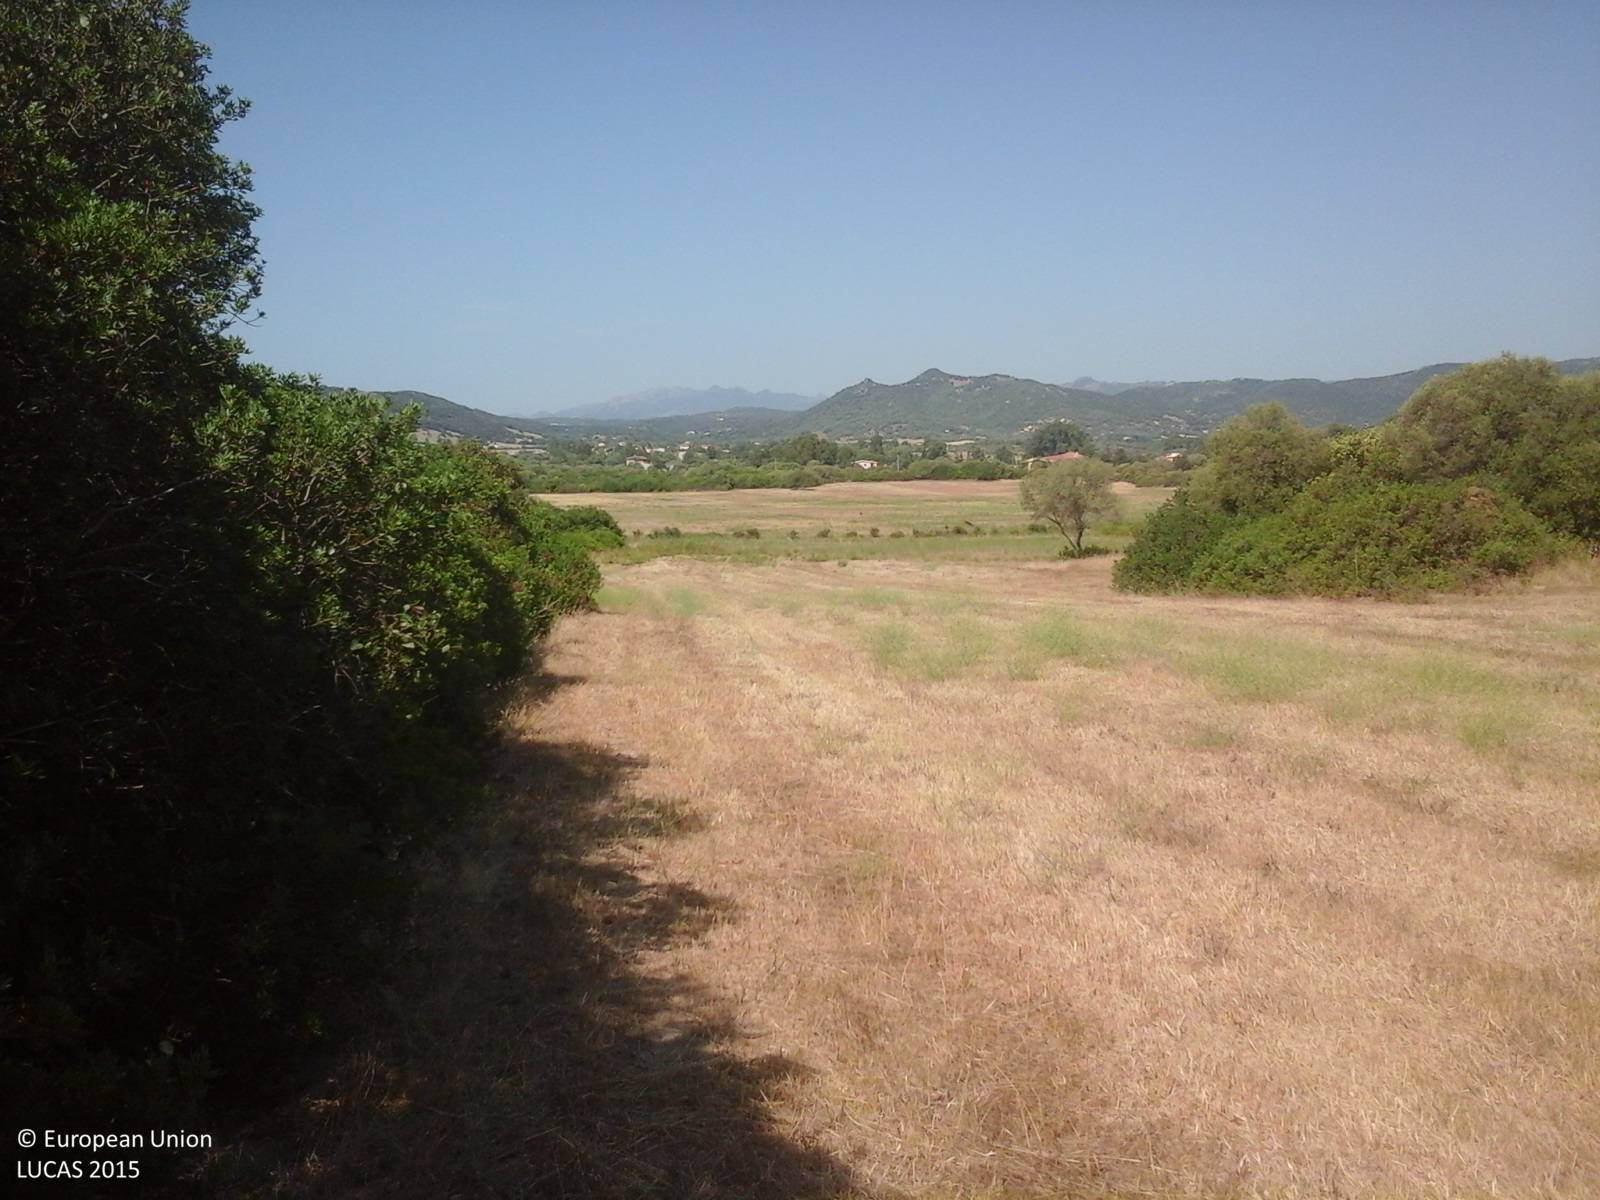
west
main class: Cropland
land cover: Temporary grasslands
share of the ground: > 75 %
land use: Agriculture (excluding fallow land and kitchen gardens)
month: July
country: IT
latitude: 40.9172
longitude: 9.4446
